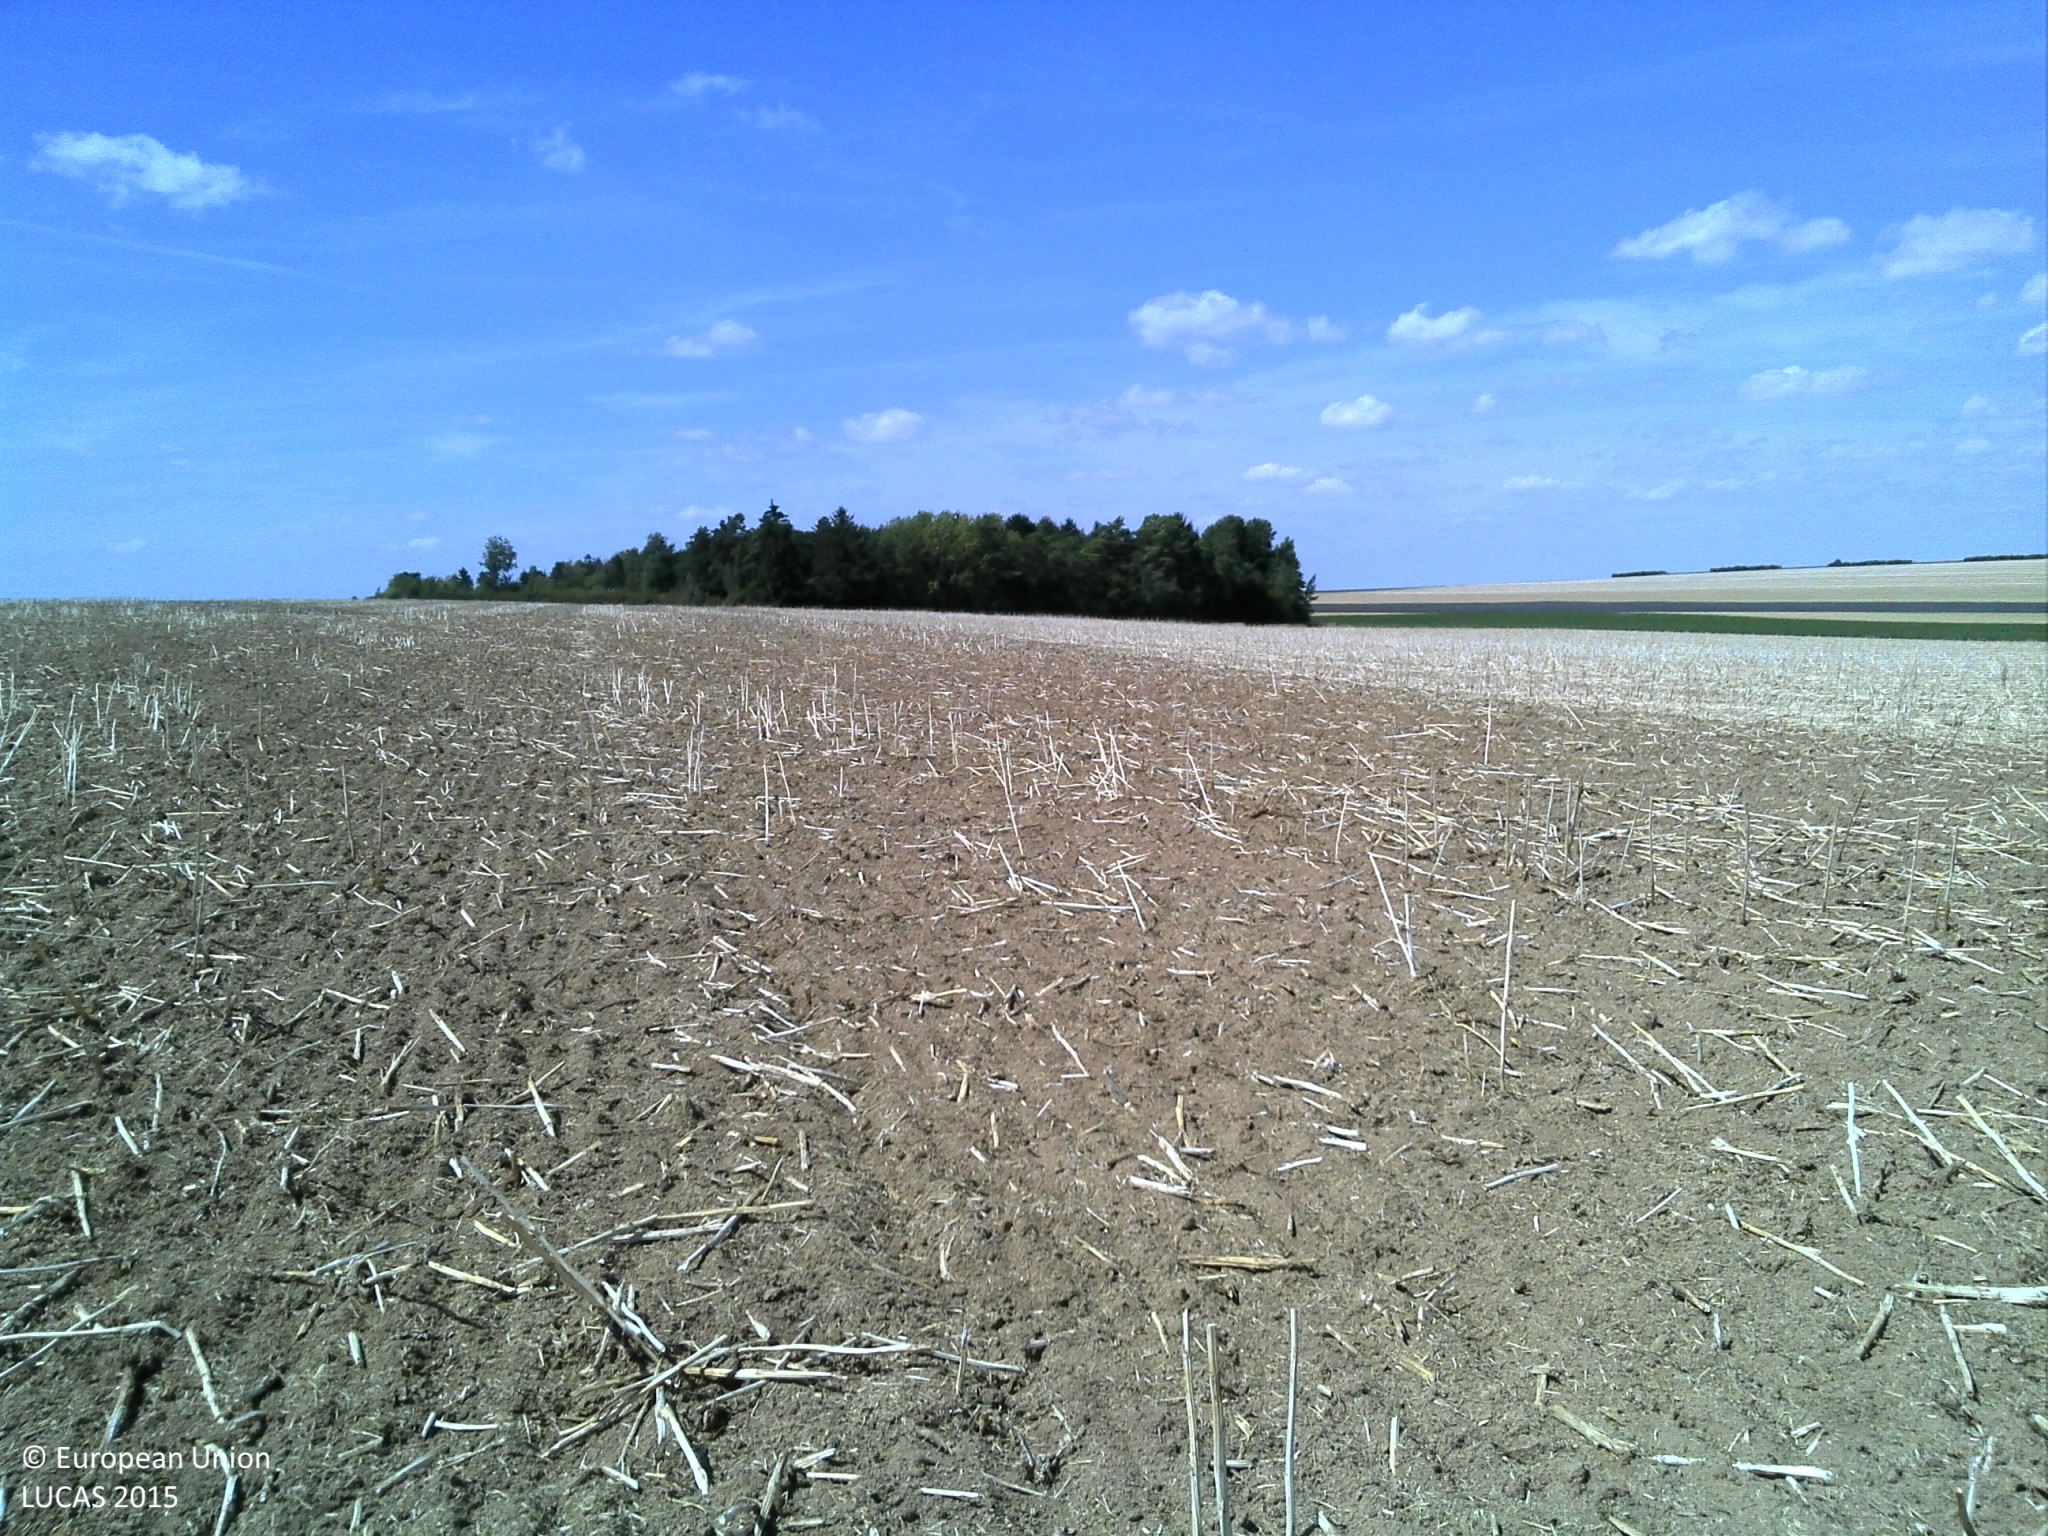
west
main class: Cropland
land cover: Rape and turnip rape
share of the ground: > 75 %
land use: Agriculture (excluding fallow land and kitchen gardens)
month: August
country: FR
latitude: 49.0133
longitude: 4.6511
